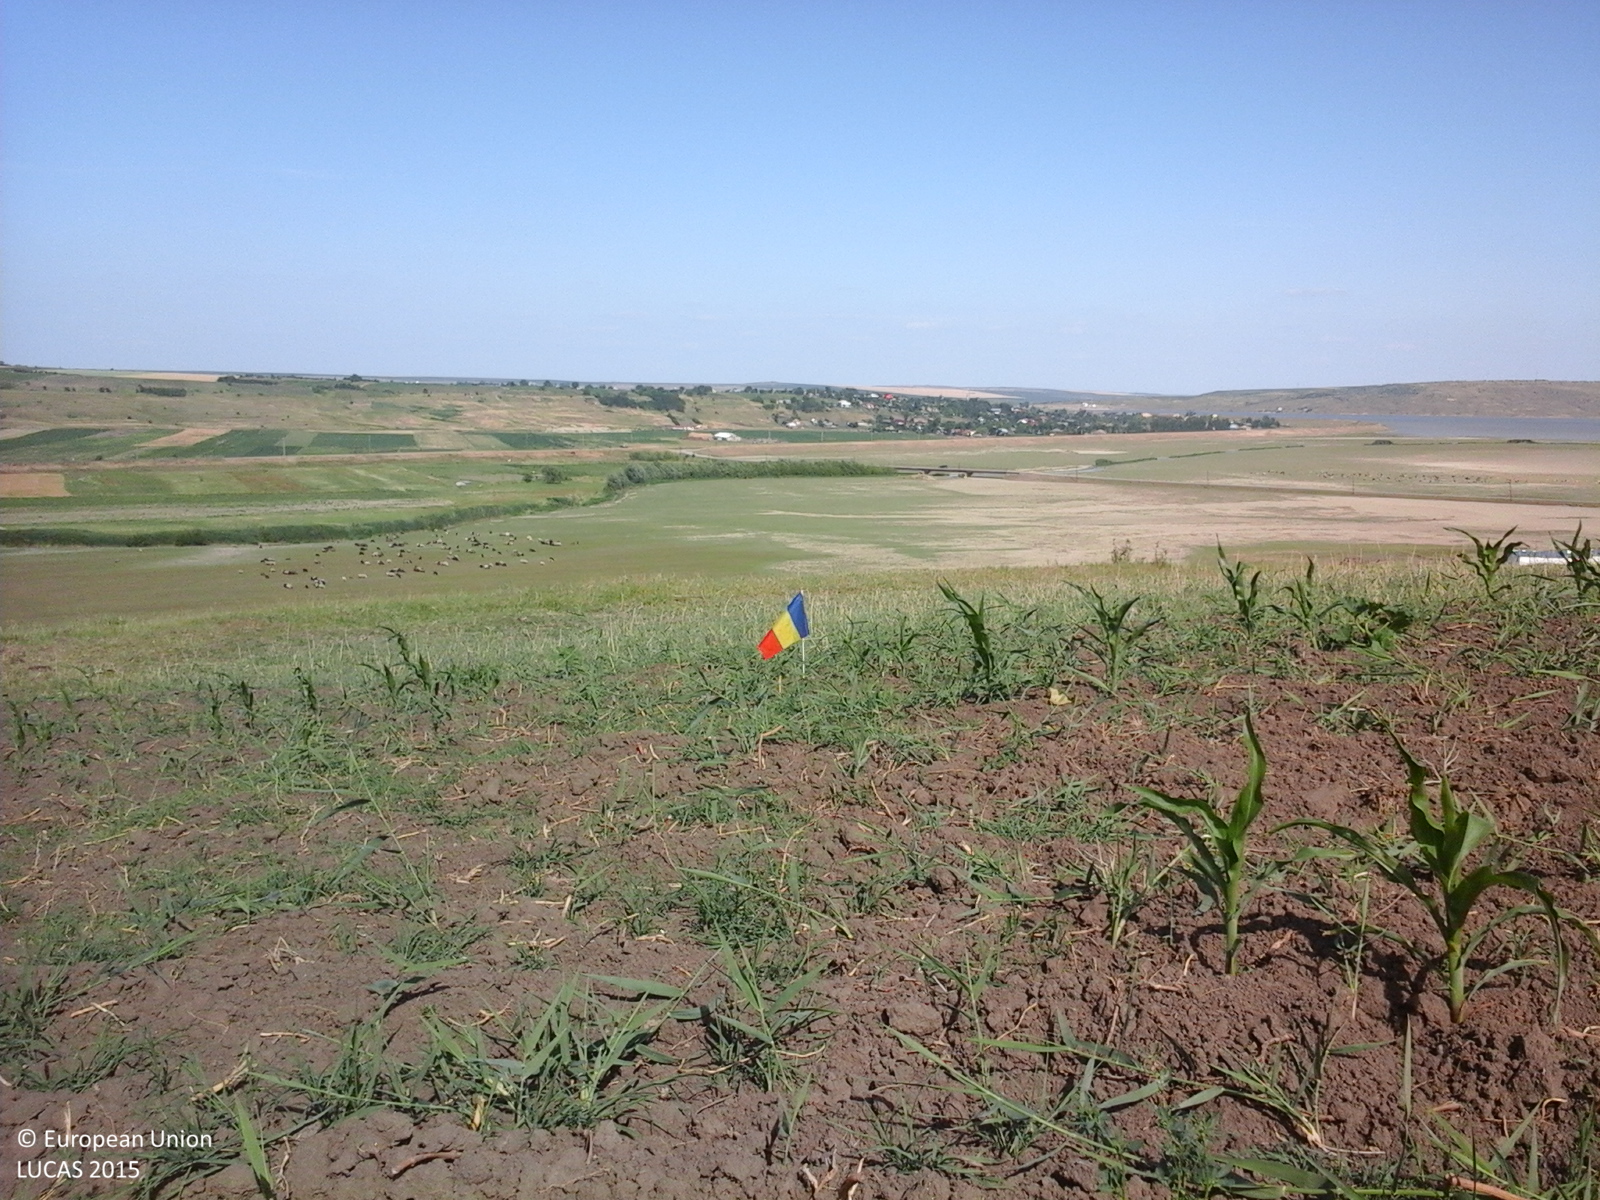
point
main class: Cropland
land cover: Maize
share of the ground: 25 - 50 %
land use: Agriculture (excluding fallow land and kitchen gardens)
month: June
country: RO
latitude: 47.3056
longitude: 27.0464
